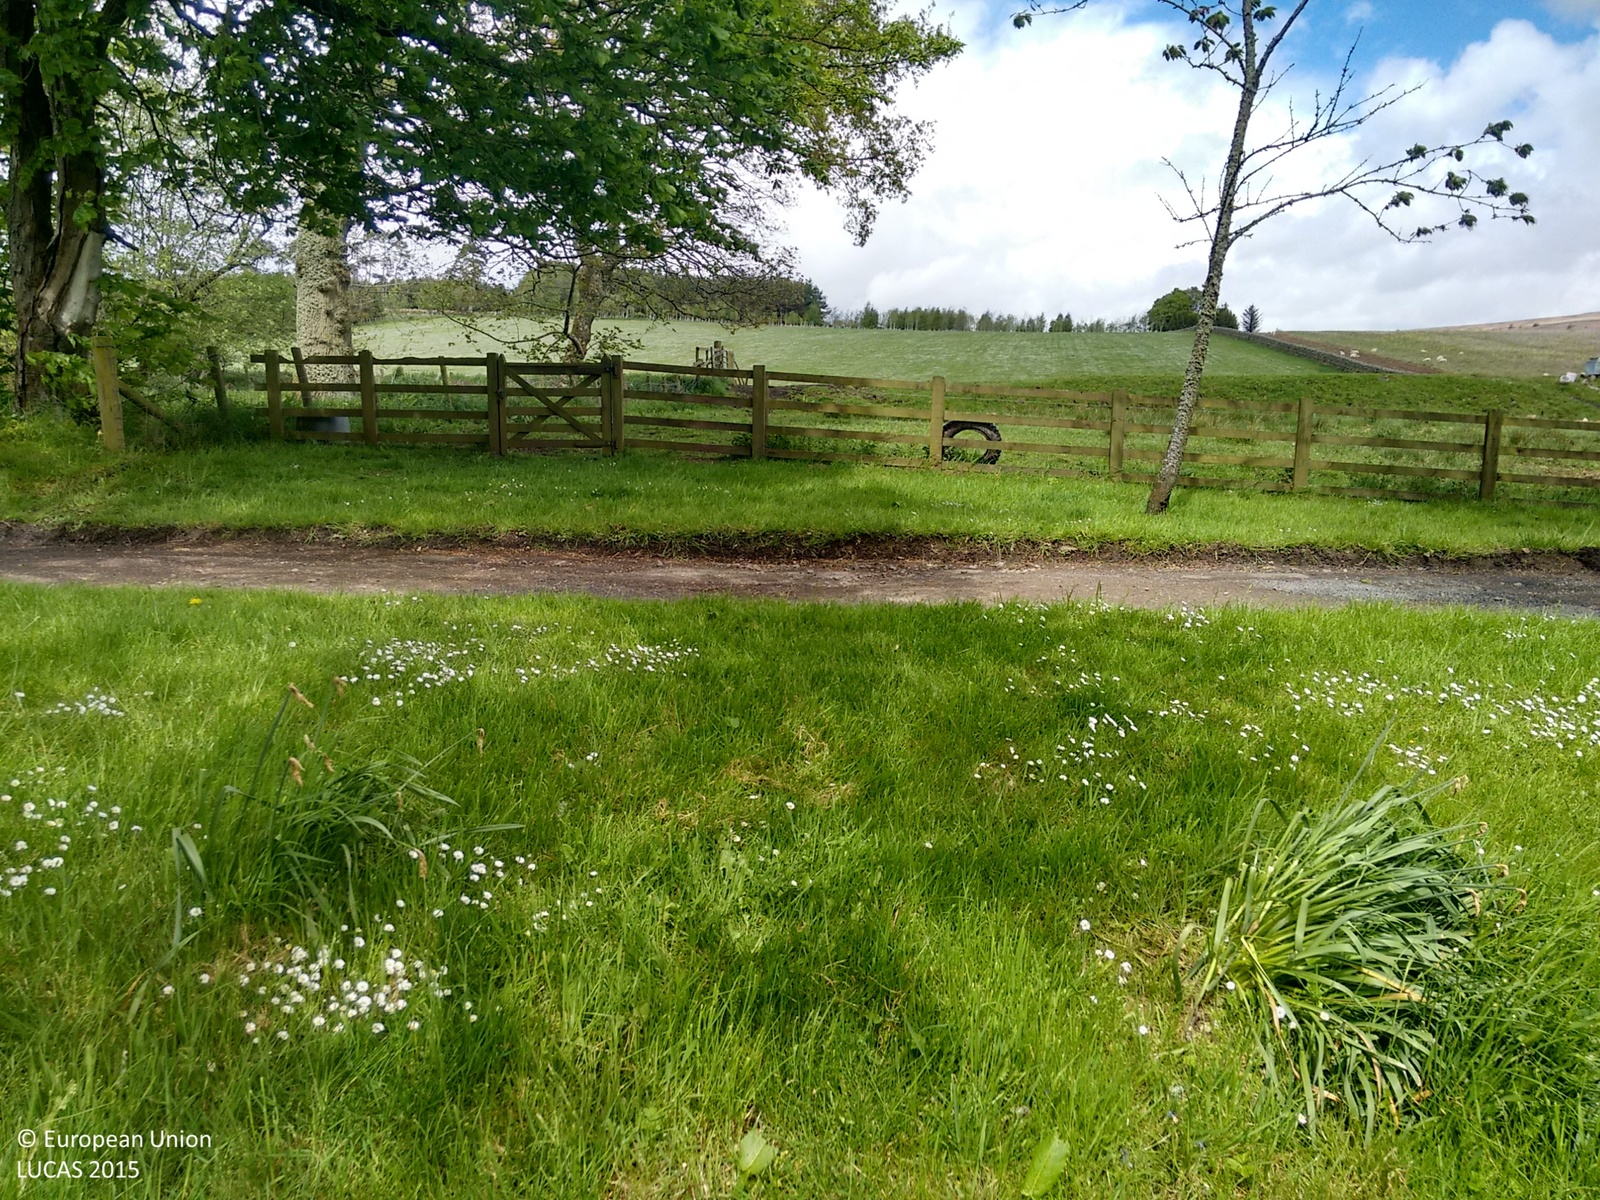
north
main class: Grassland
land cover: Grassland with sparse tree/shrub cover
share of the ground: > 75 %
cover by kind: herbaceous plants 95 %, broadleaved forest trees 5 %
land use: Residential
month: May
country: GB
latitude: 55.1547
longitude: -2.3157
